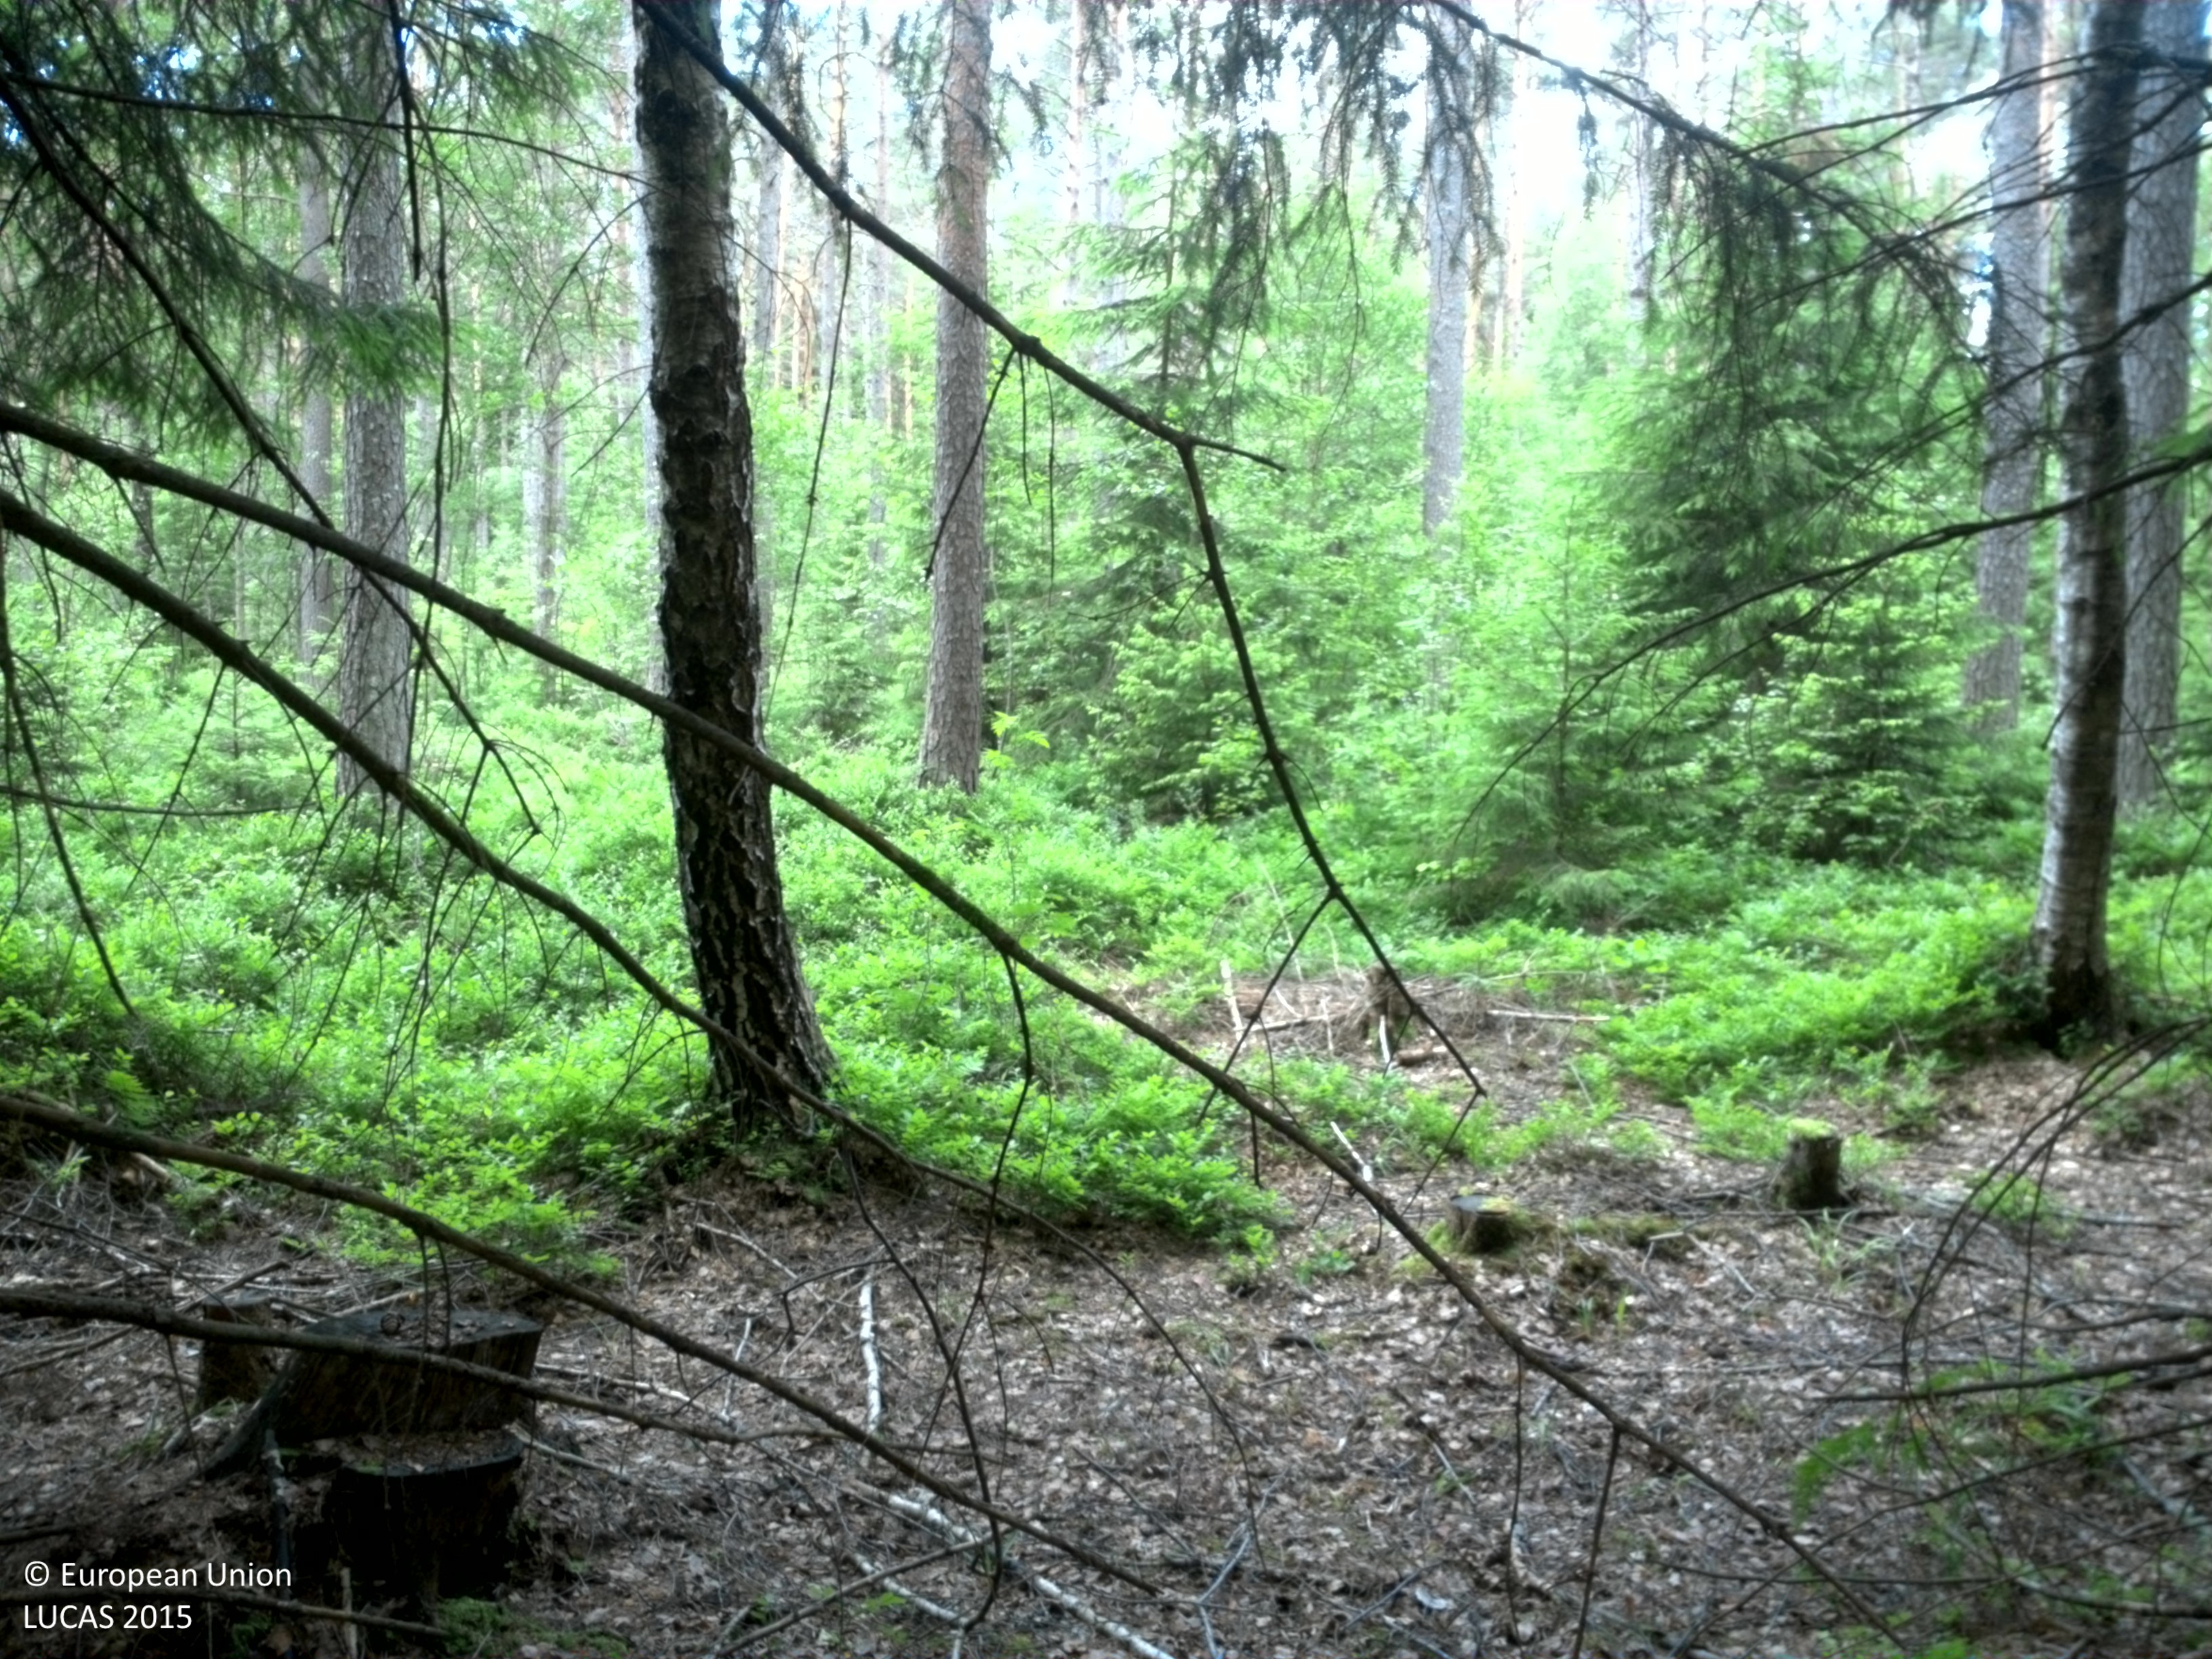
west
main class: Woodland
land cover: Spruce dominated coniferous woodland
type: boreal forest
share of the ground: 50 - 75 %
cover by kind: coniferous forest trees 70 %, herbaceous plants 10 %, consolidated bare surface 10 %, broadleaved forest trees 5 %, lichens and mosses 5 %
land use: Forestry
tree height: > 5 m
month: June
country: SE
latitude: 58.5629
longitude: 15.3743
